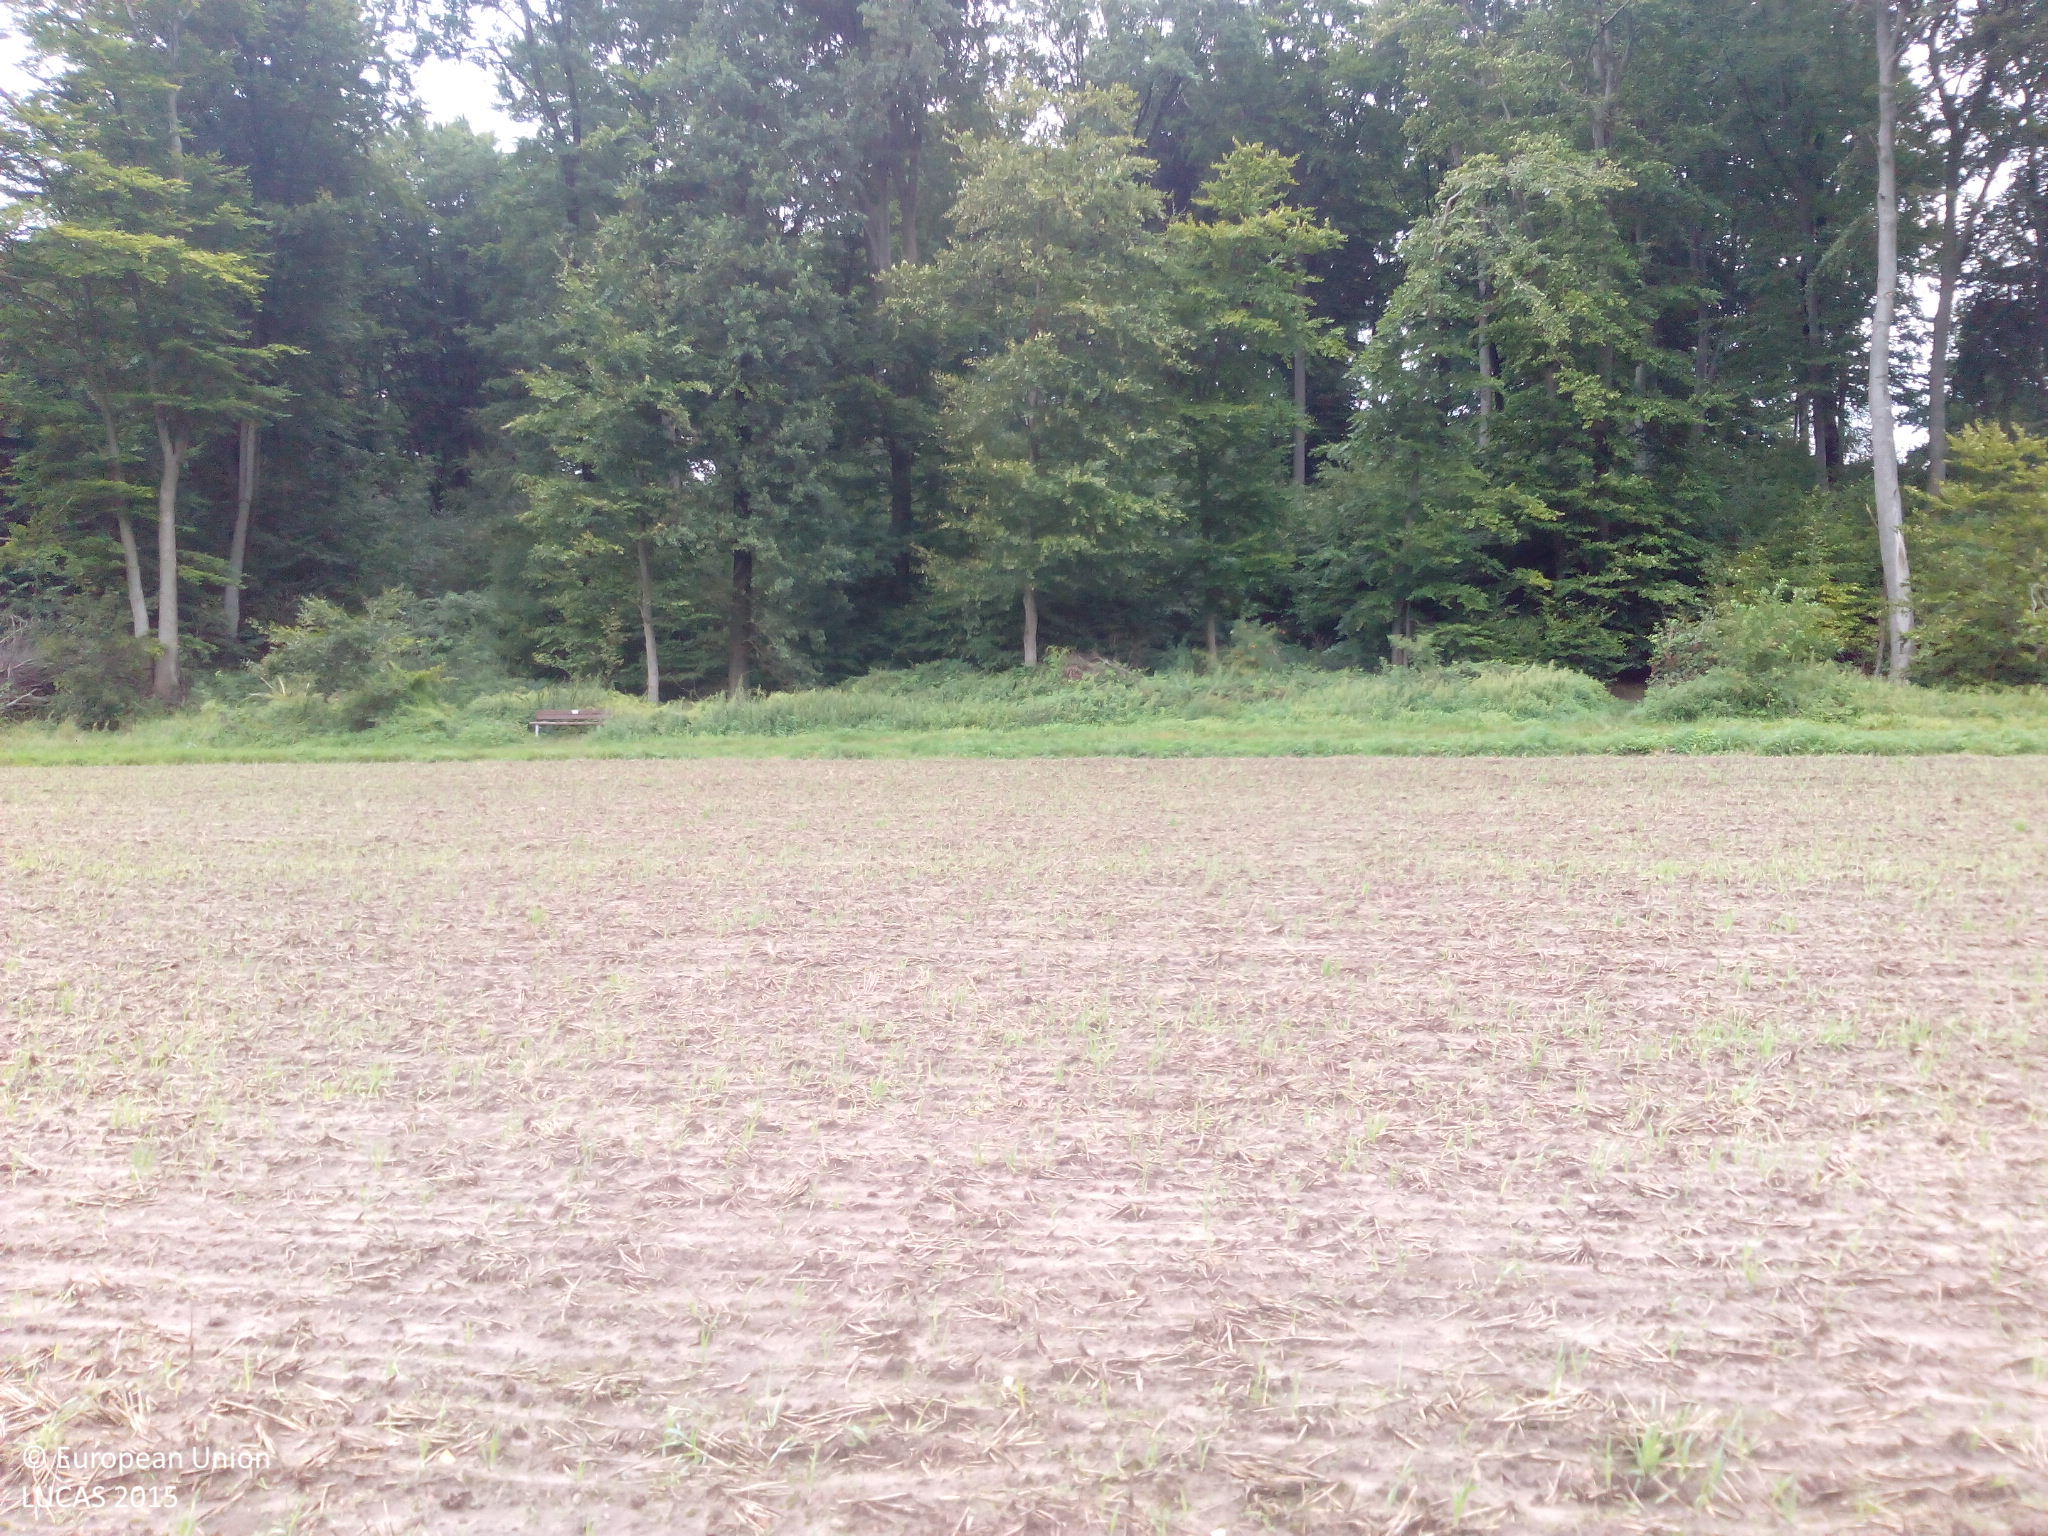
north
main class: Grassland
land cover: Spontaneously vegetated surfaces
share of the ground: 25 - 50 %
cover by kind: unconsolidated bare surface 75 %, herbaceous plants 25 %
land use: Agriculture (excluding fallow land and kitchen gardens)
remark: Harvested field
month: August
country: DE
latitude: 52.1454
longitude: 8.0276
